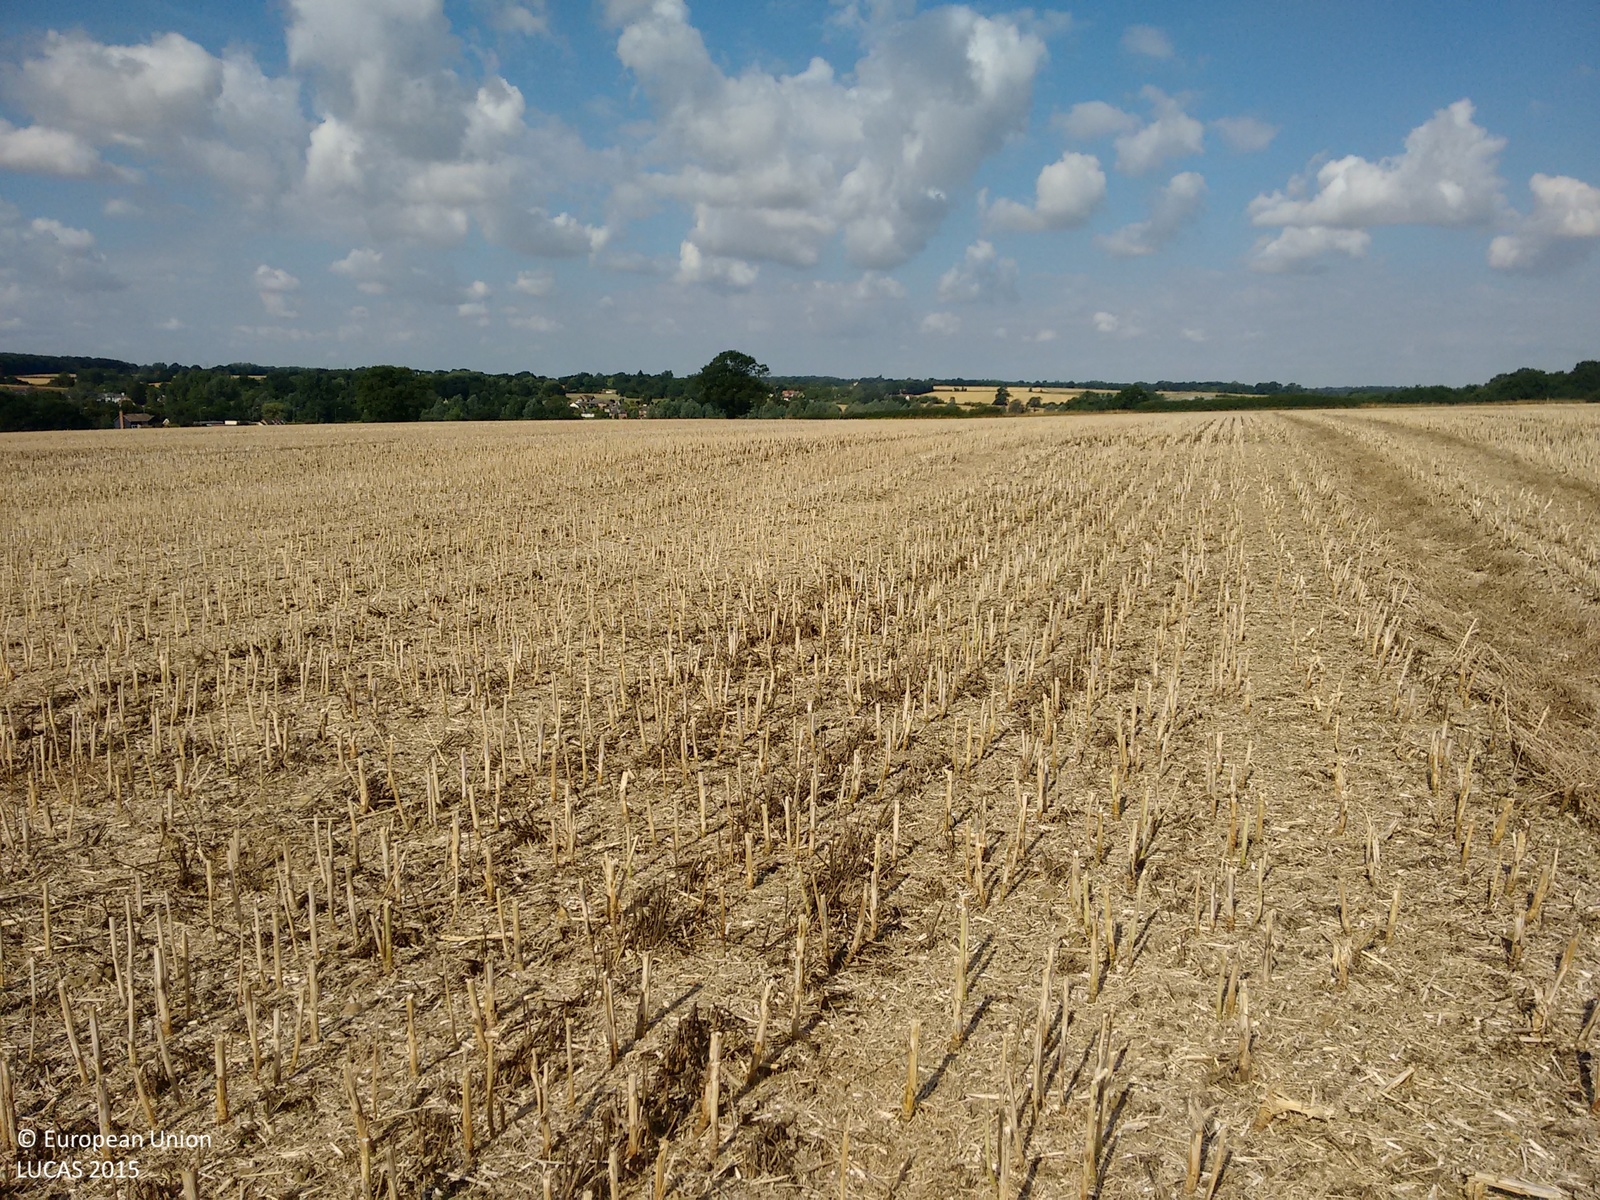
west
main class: Cropland
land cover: Rape and turnip rape
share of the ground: 25 - 50 %
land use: Agriculture (excluding fallow land and kitchen gardens)
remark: Harvested field
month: July
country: GB
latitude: 51.8797
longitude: 0.6327
